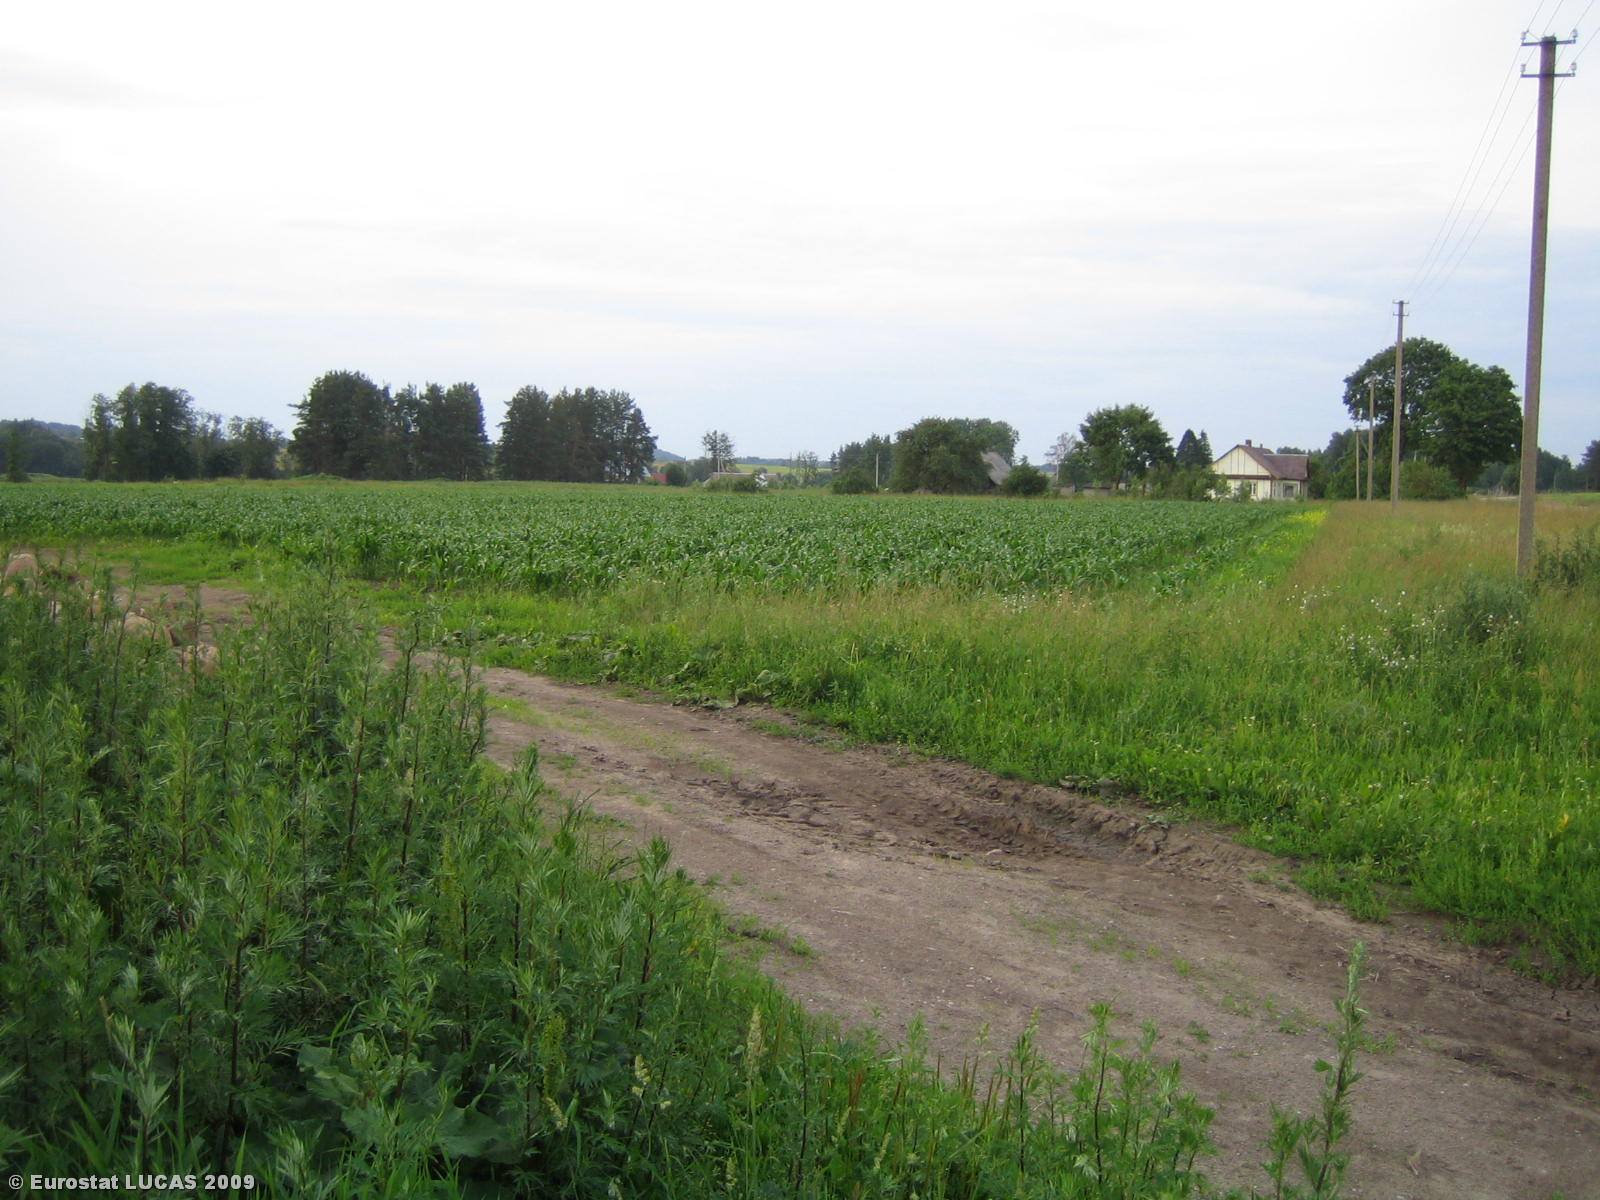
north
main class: Grassland
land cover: Grassland without tree/shrub cover
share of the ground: > 75 %
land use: Agriculture (excluding fallow land and kitchen gardens)
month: July
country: LT
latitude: 55.6486
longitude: 25.5877
